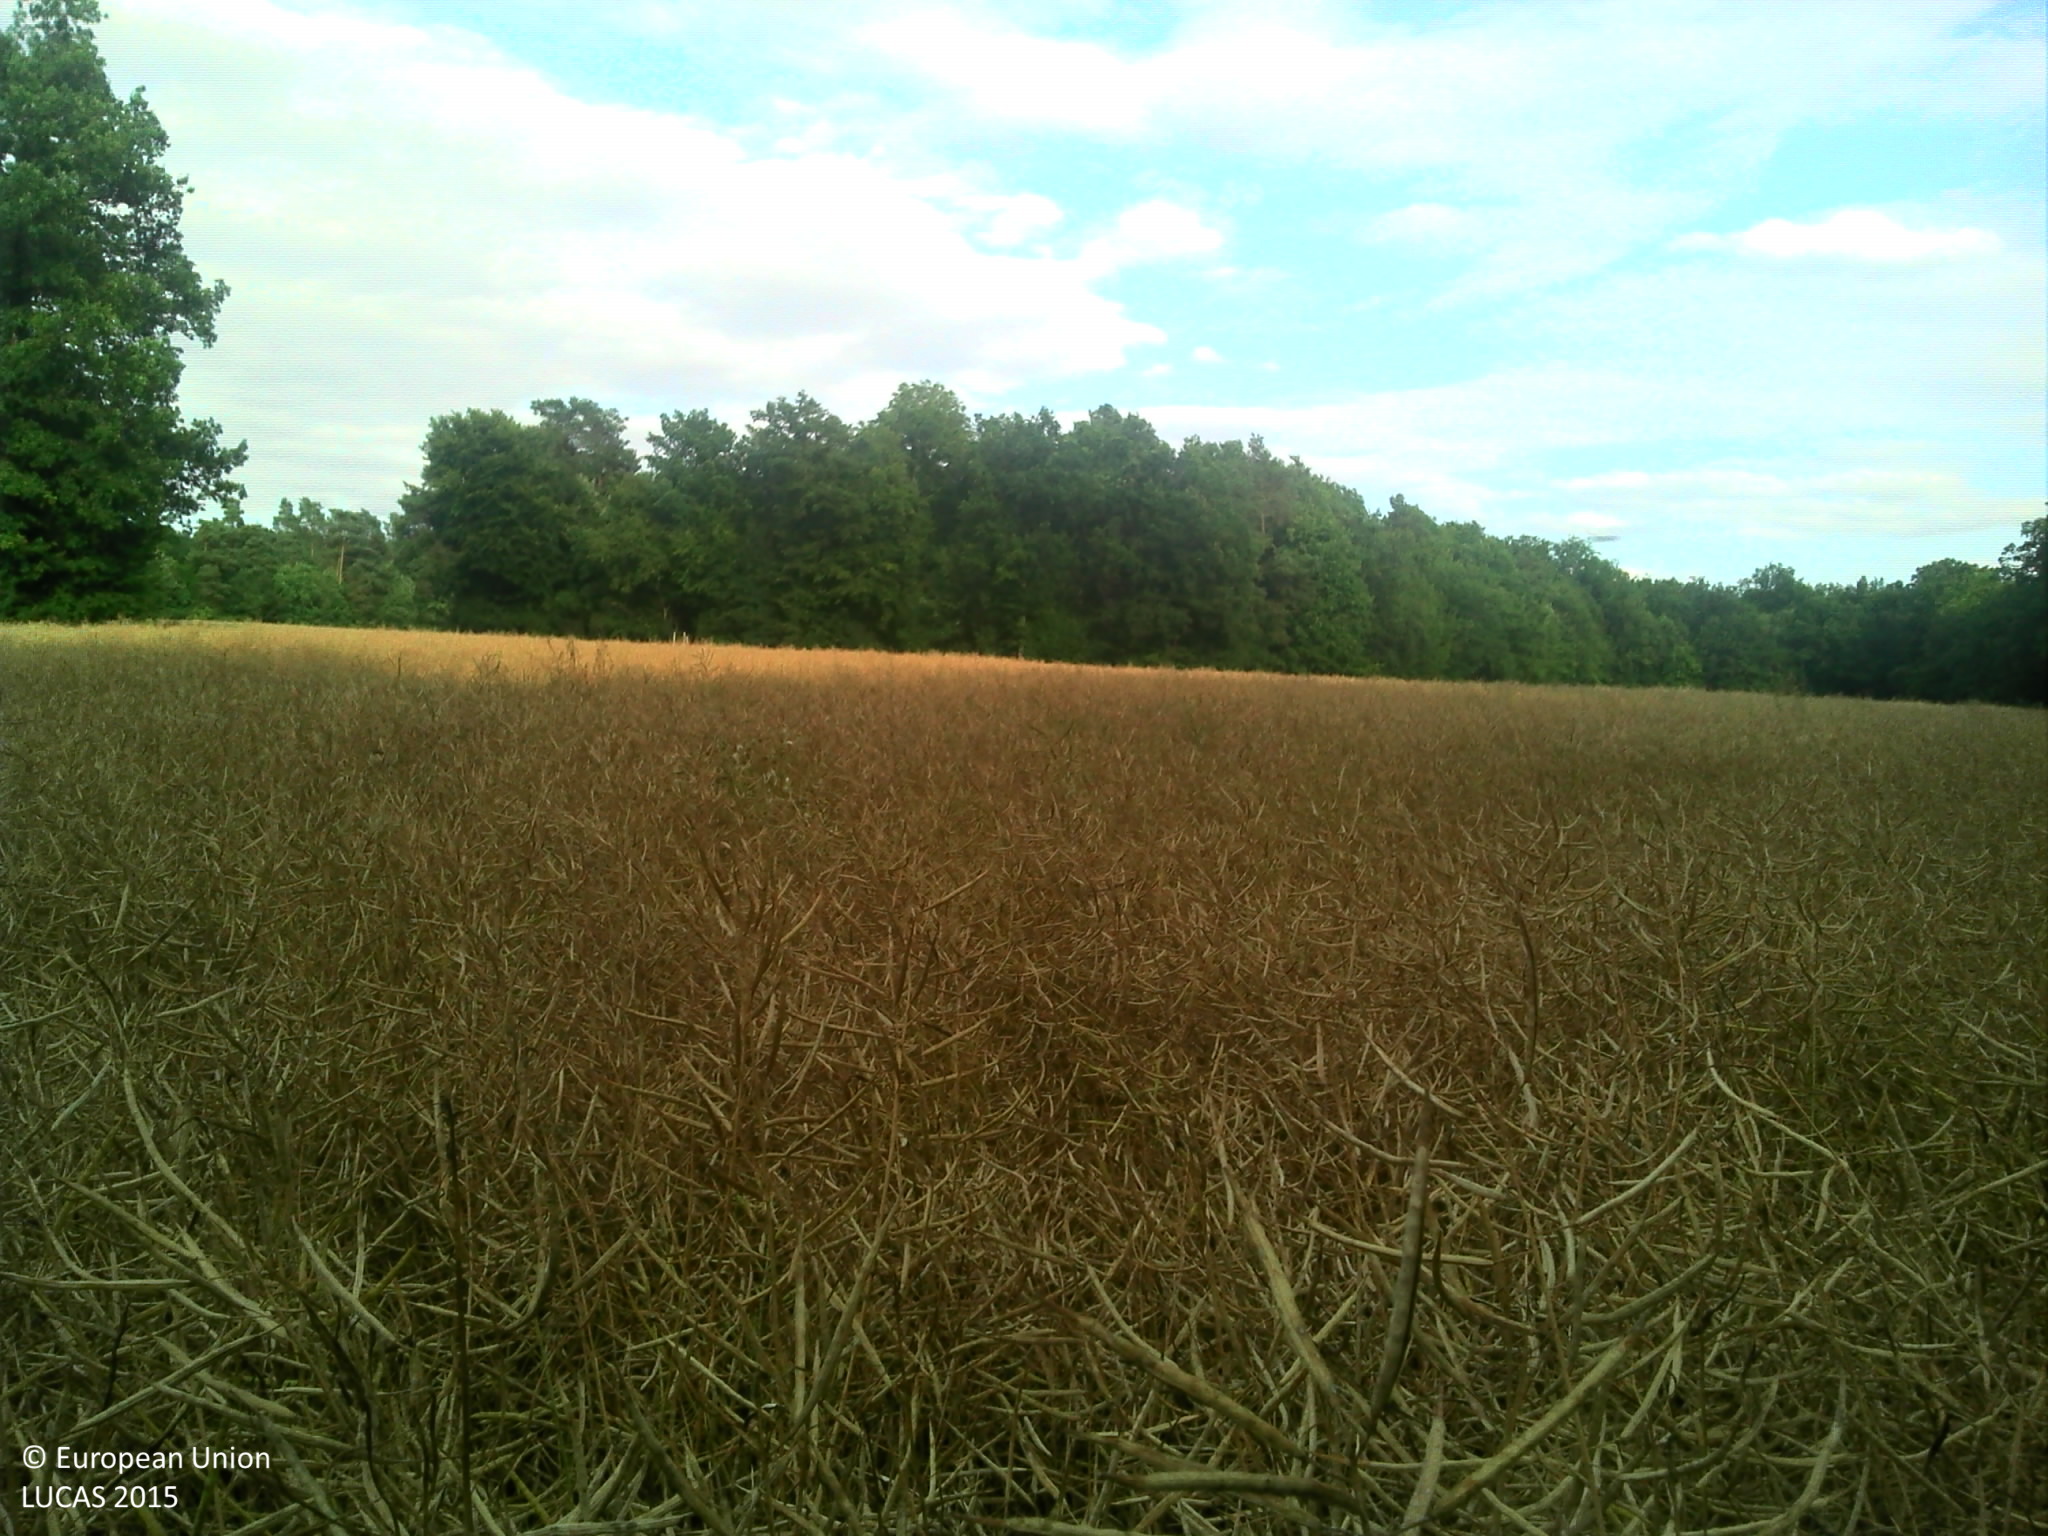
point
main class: Cropland
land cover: Rape and turnip rape
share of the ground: > 75 %
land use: Agriculture (excluding fallow land and kitchen gardens)
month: July
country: FR
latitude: 48.0833
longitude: 5.2070
